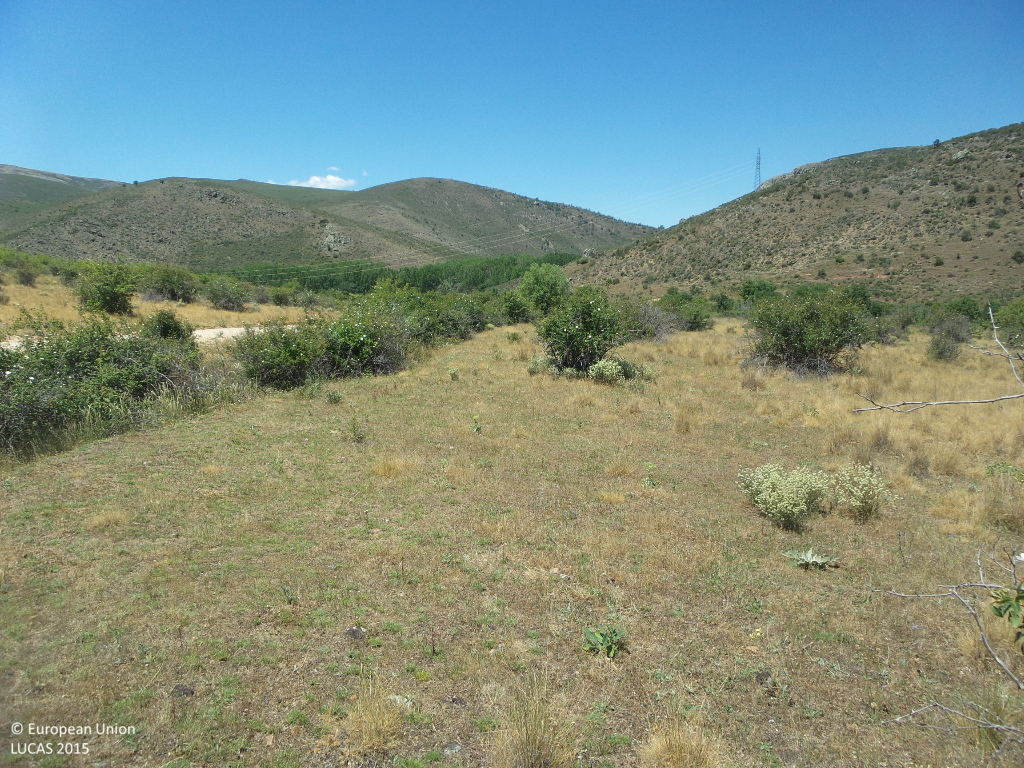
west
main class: Shrubland
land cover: Shrubland without tree cover
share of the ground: 10 - 25 %
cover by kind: herbaceous plants 70 %, shrubs 20 %, unconsolidated bare surface 10 %
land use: Semi-natural and natural areas not in use
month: June
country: ES
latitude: 41.1649
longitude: -2.9203
